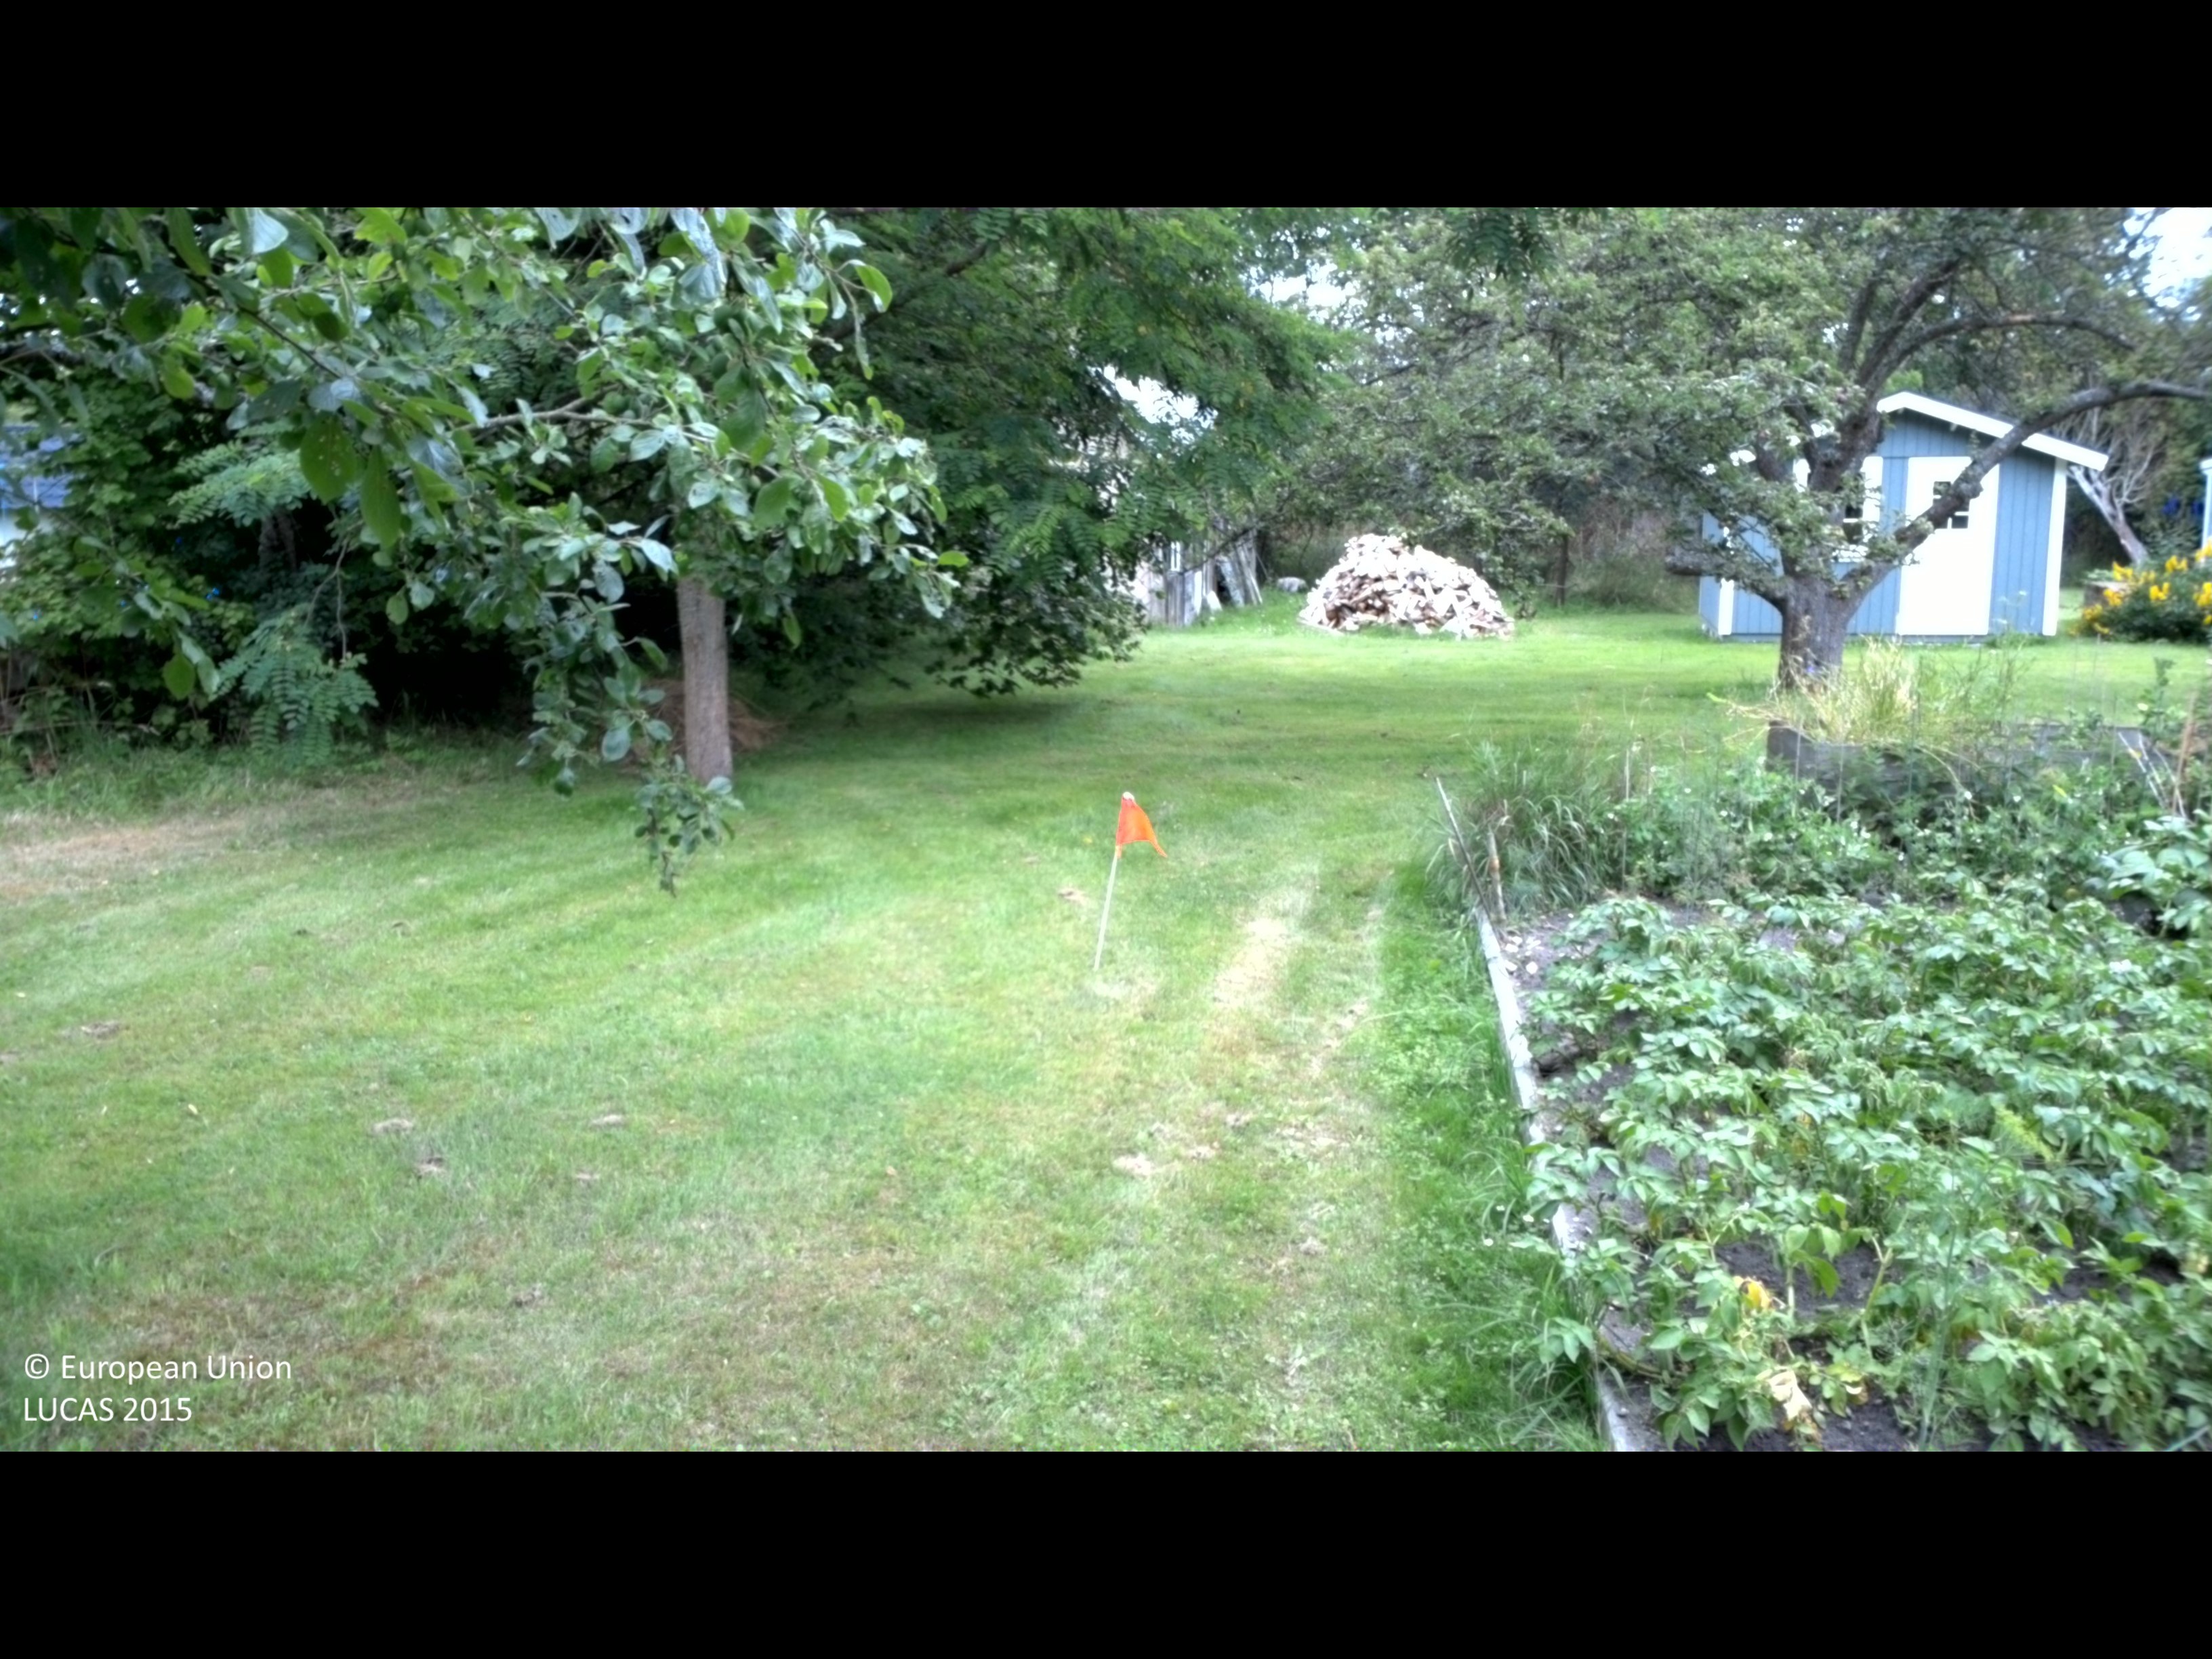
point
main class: Woodland
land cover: Broadleaved woodland
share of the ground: 10 - 25 %
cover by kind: herbaceous plants 75 %, broadleaved forest trees 25 %
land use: Residential
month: July
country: SE
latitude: 57.0844
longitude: 16.9153
